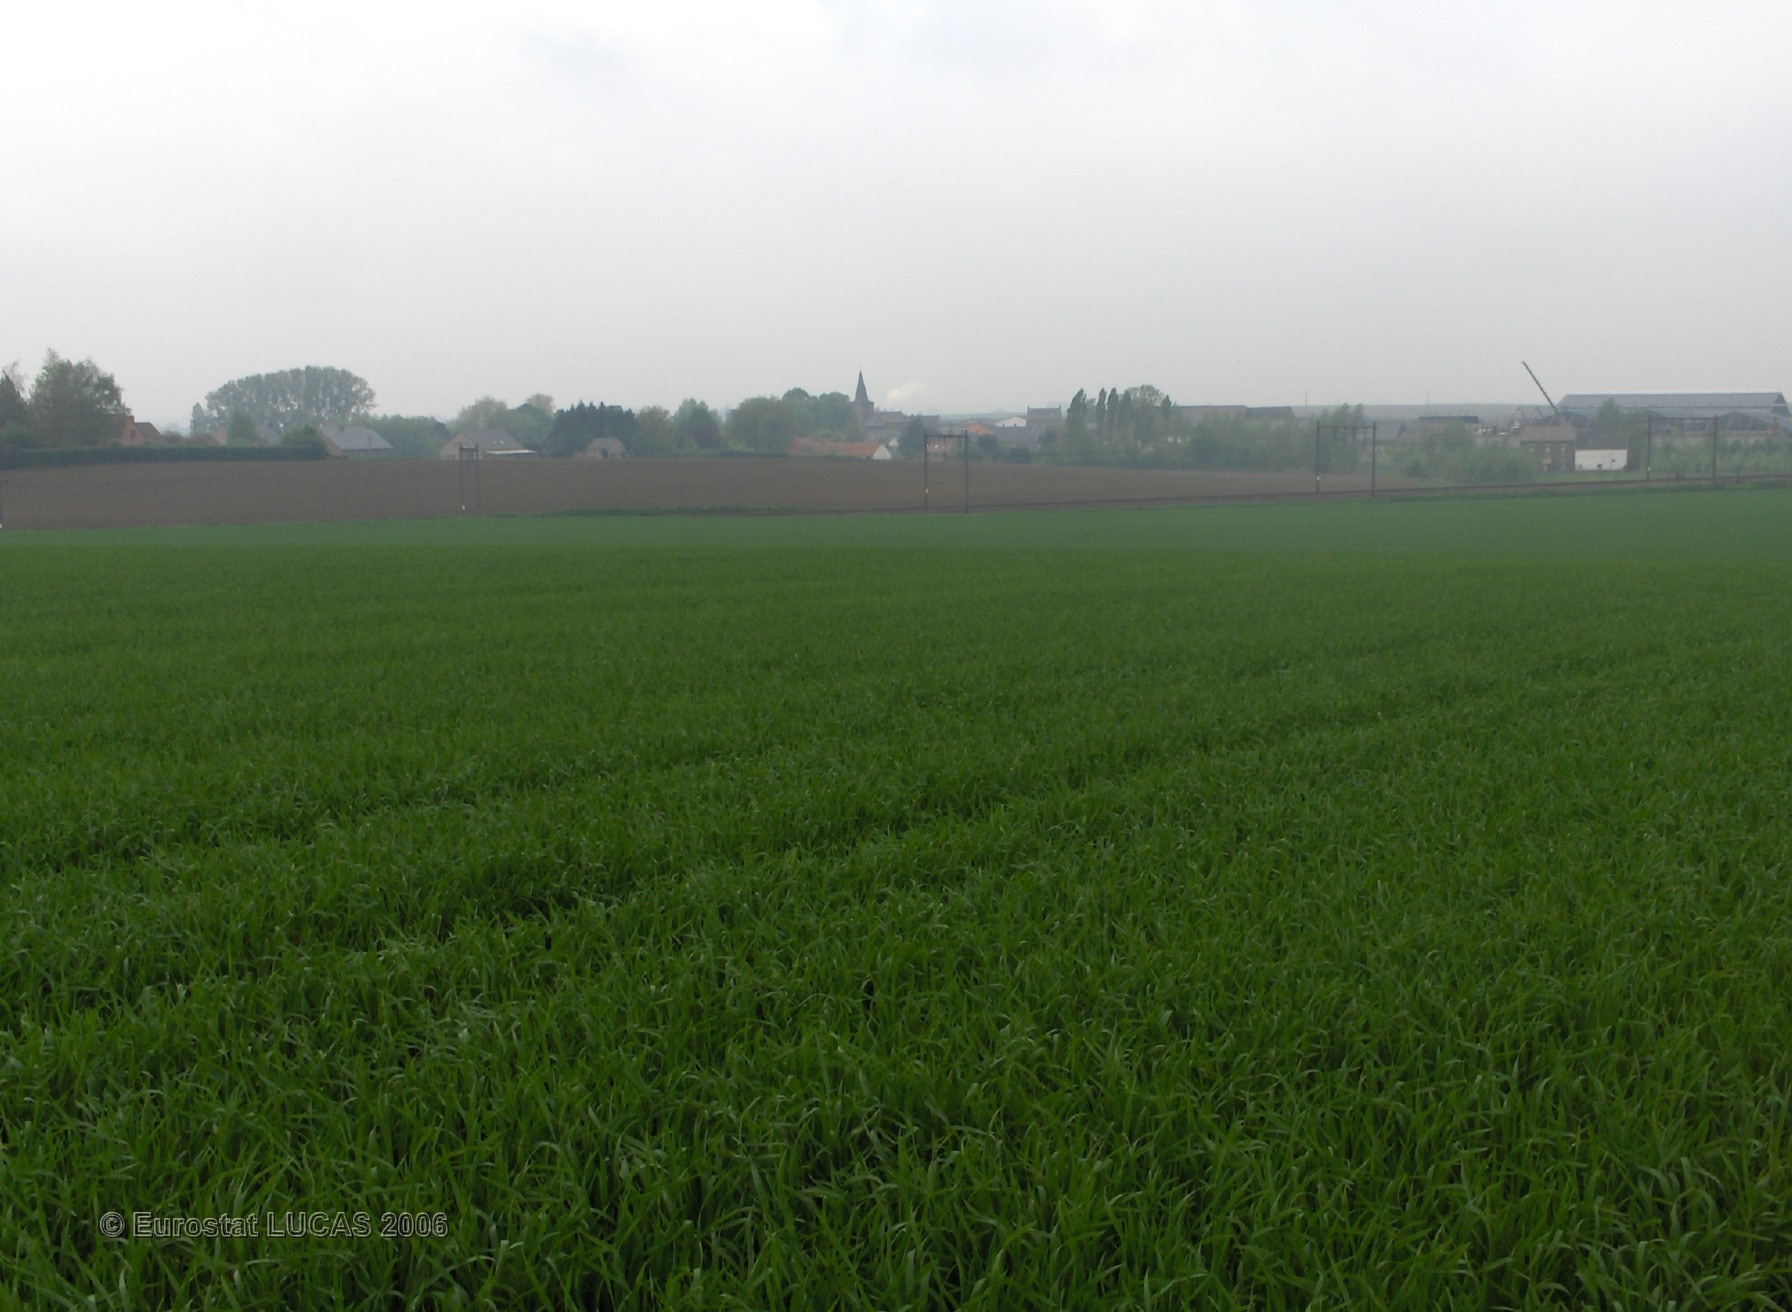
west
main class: Cropland
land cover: Common wheat
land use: Agriculture (excluding fallow land and kitchen gardens)
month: May
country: BE
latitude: 50.5233
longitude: 4.5655
